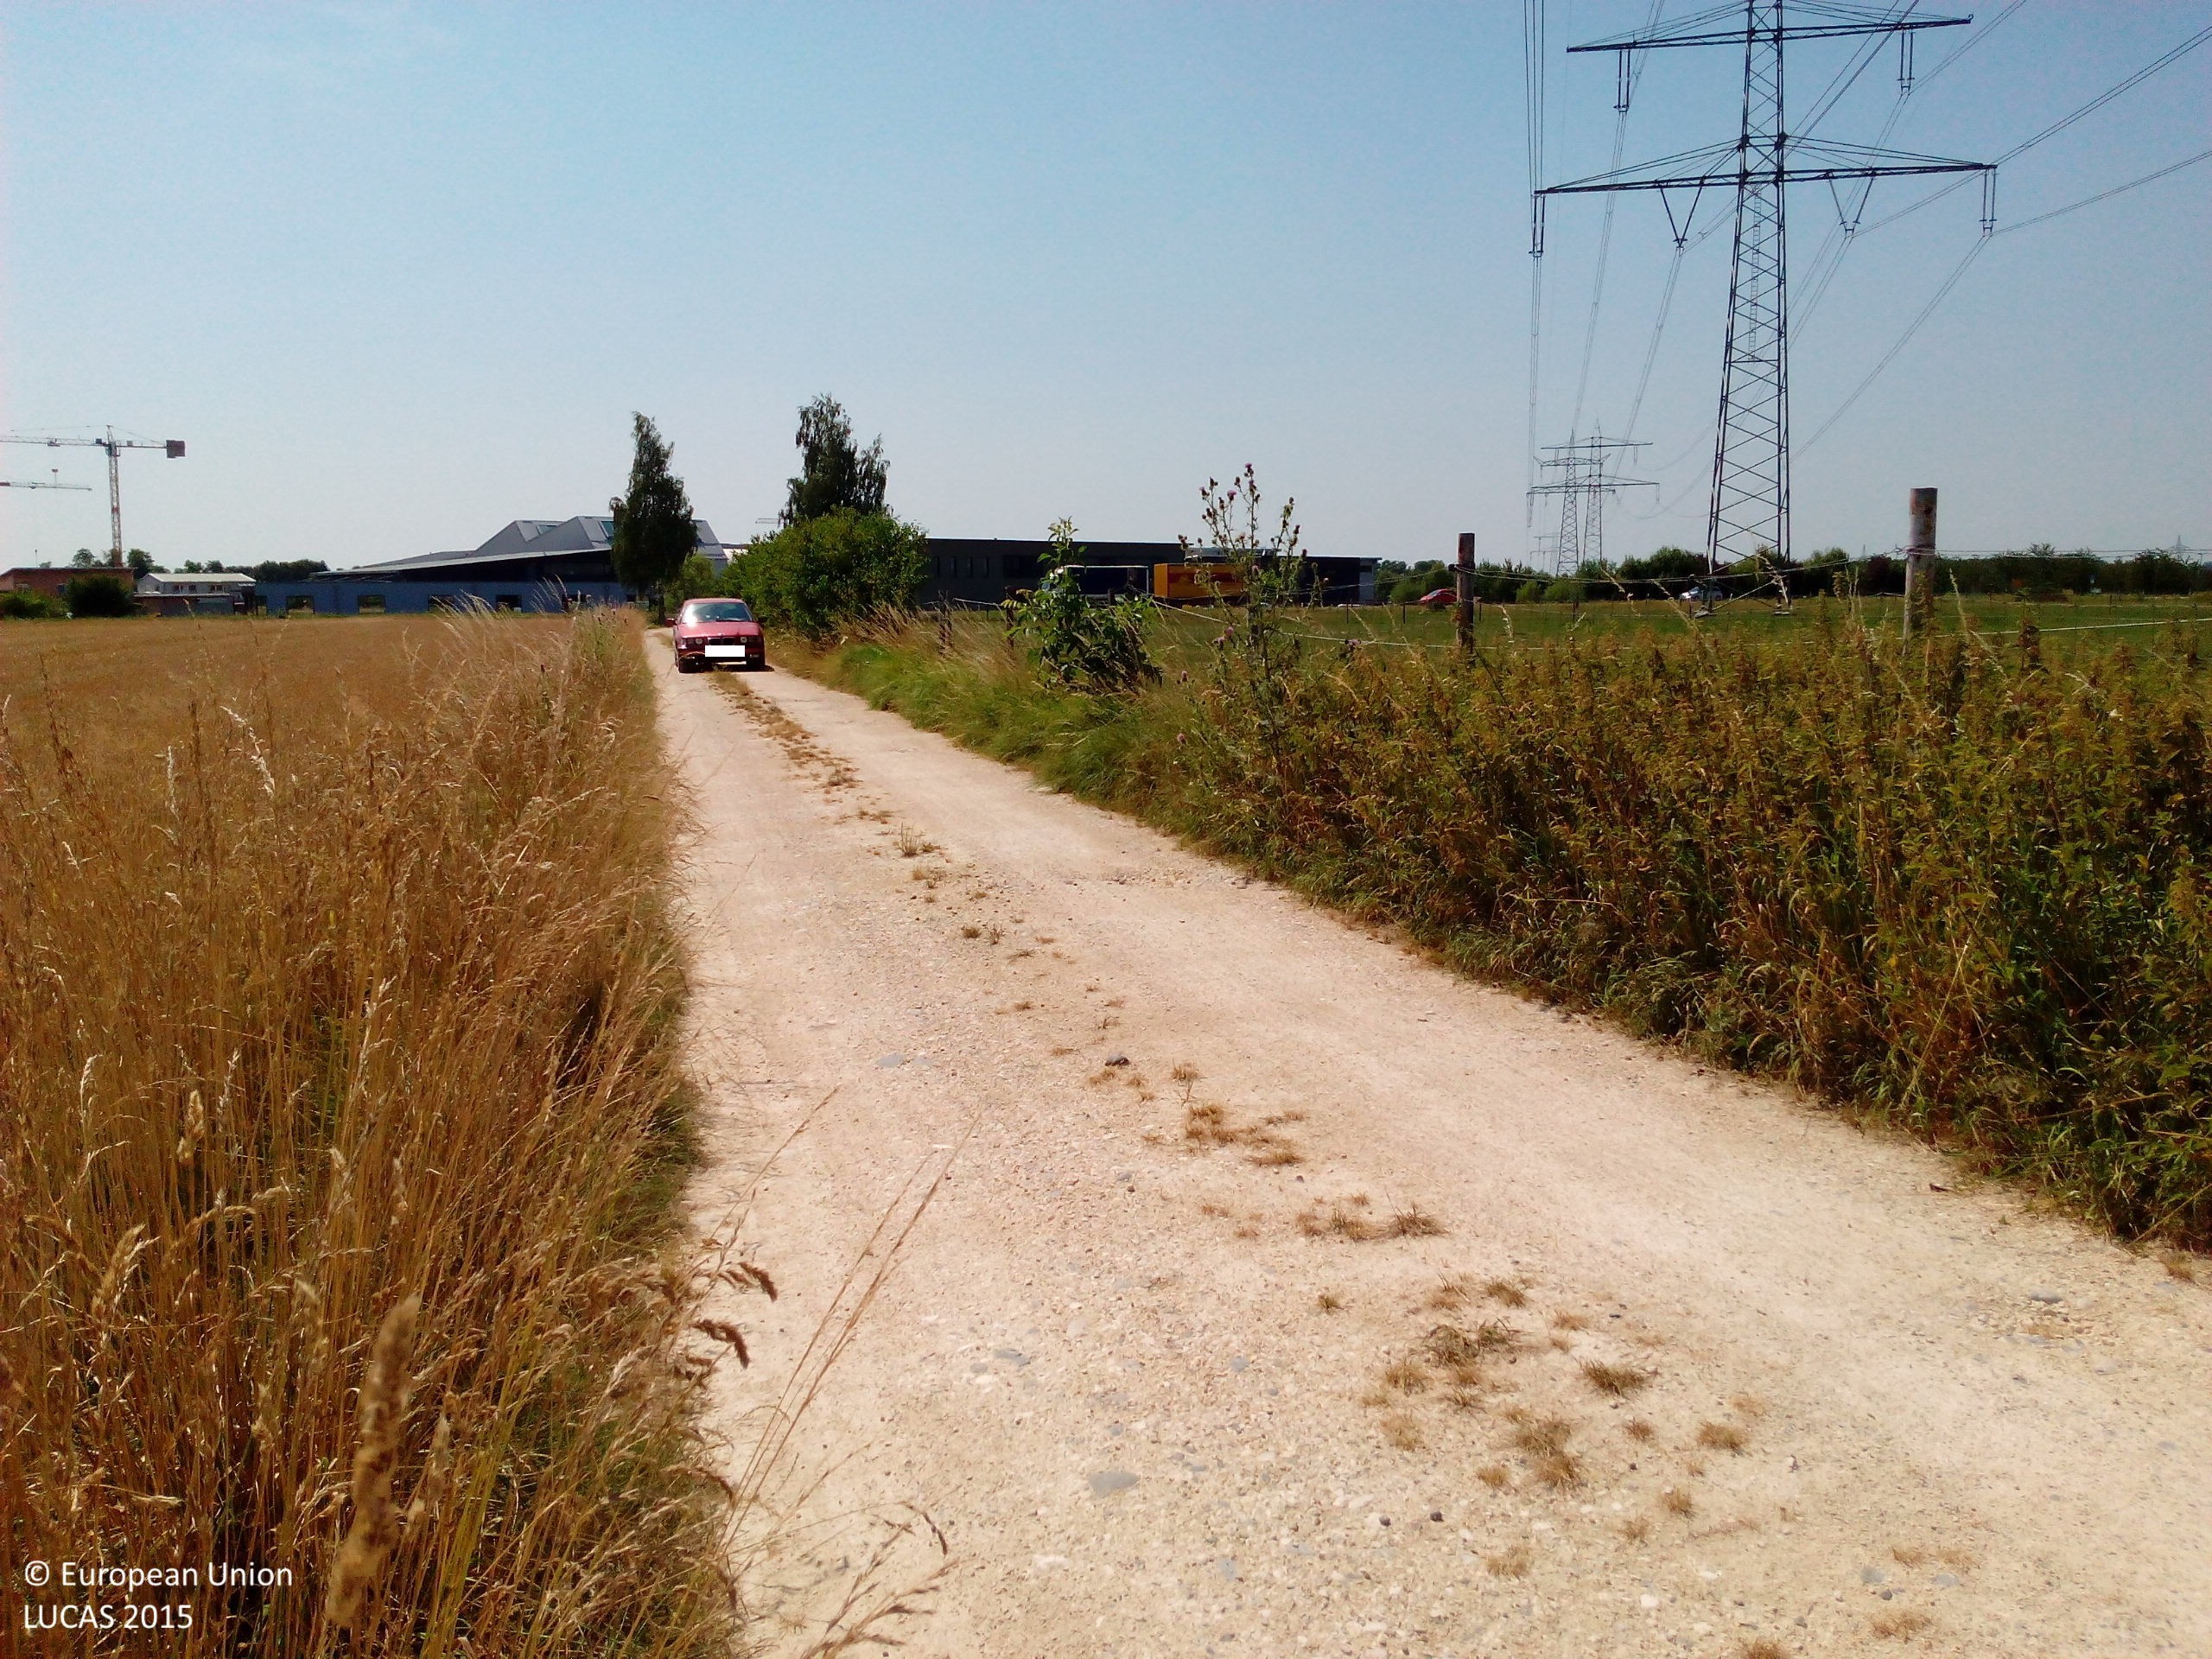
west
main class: Cropland
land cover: Common wheat
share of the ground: > 75 %
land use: Agriculture (excluding fallow land and kitchen gardens)
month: July
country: DE
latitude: 47.6391
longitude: 7.5924
